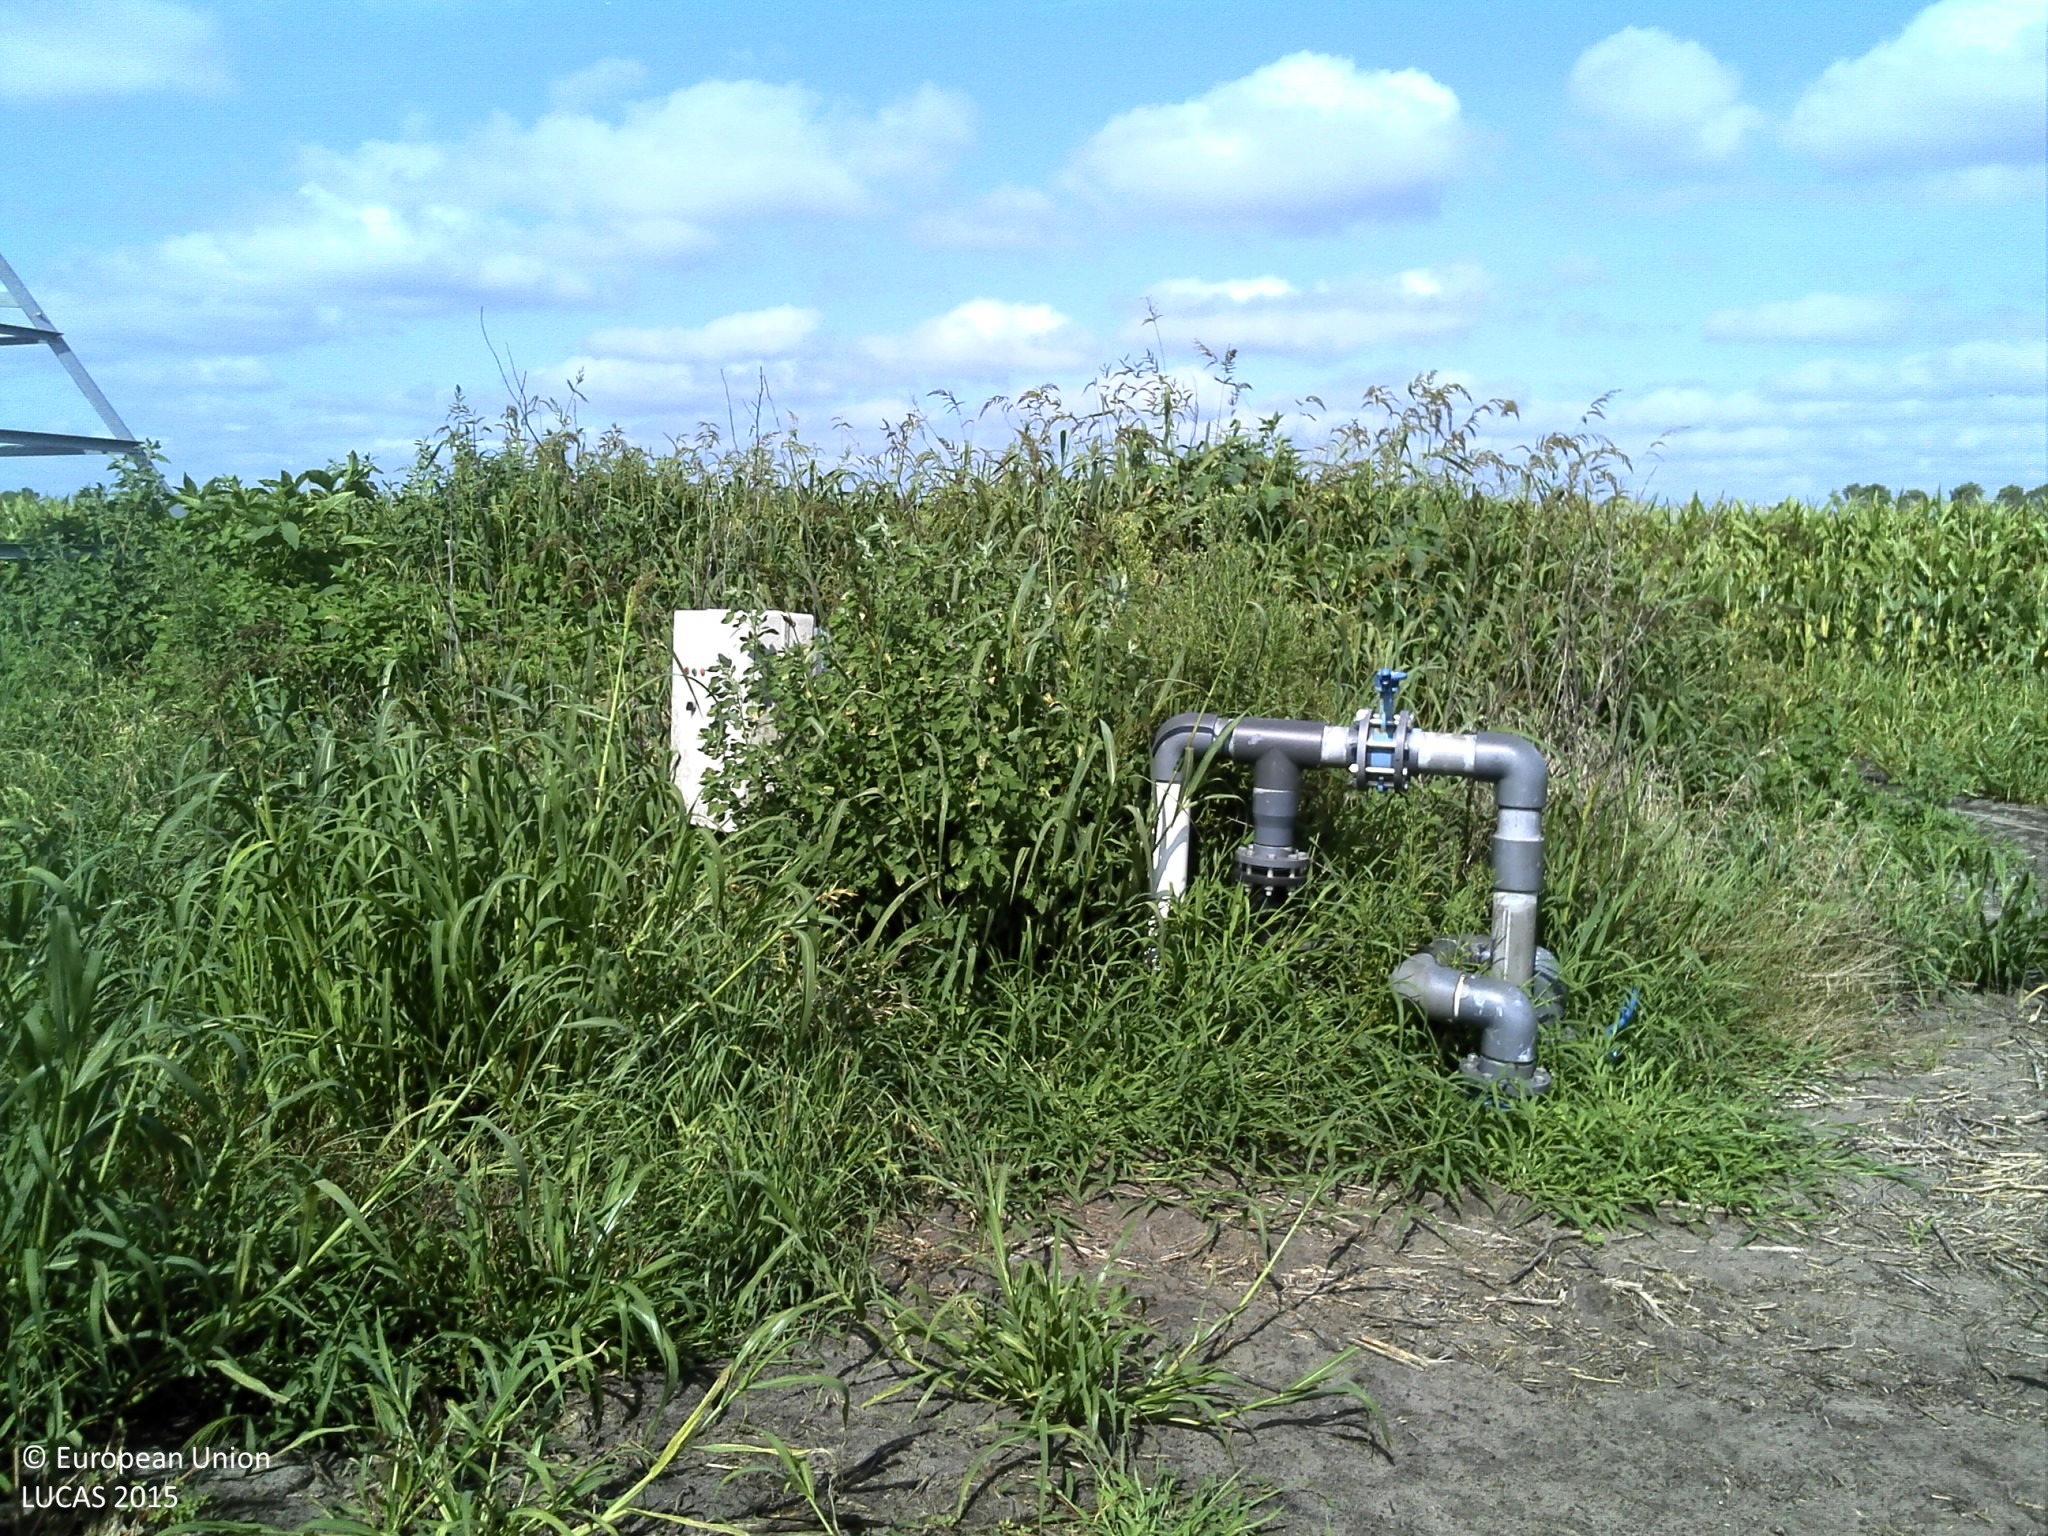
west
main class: Cropland
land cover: Maize
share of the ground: > 75 %
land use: Agriculture (excluding fallow land and kitchen gardens)
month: August
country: FR
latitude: 44.3752
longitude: -0.5451
